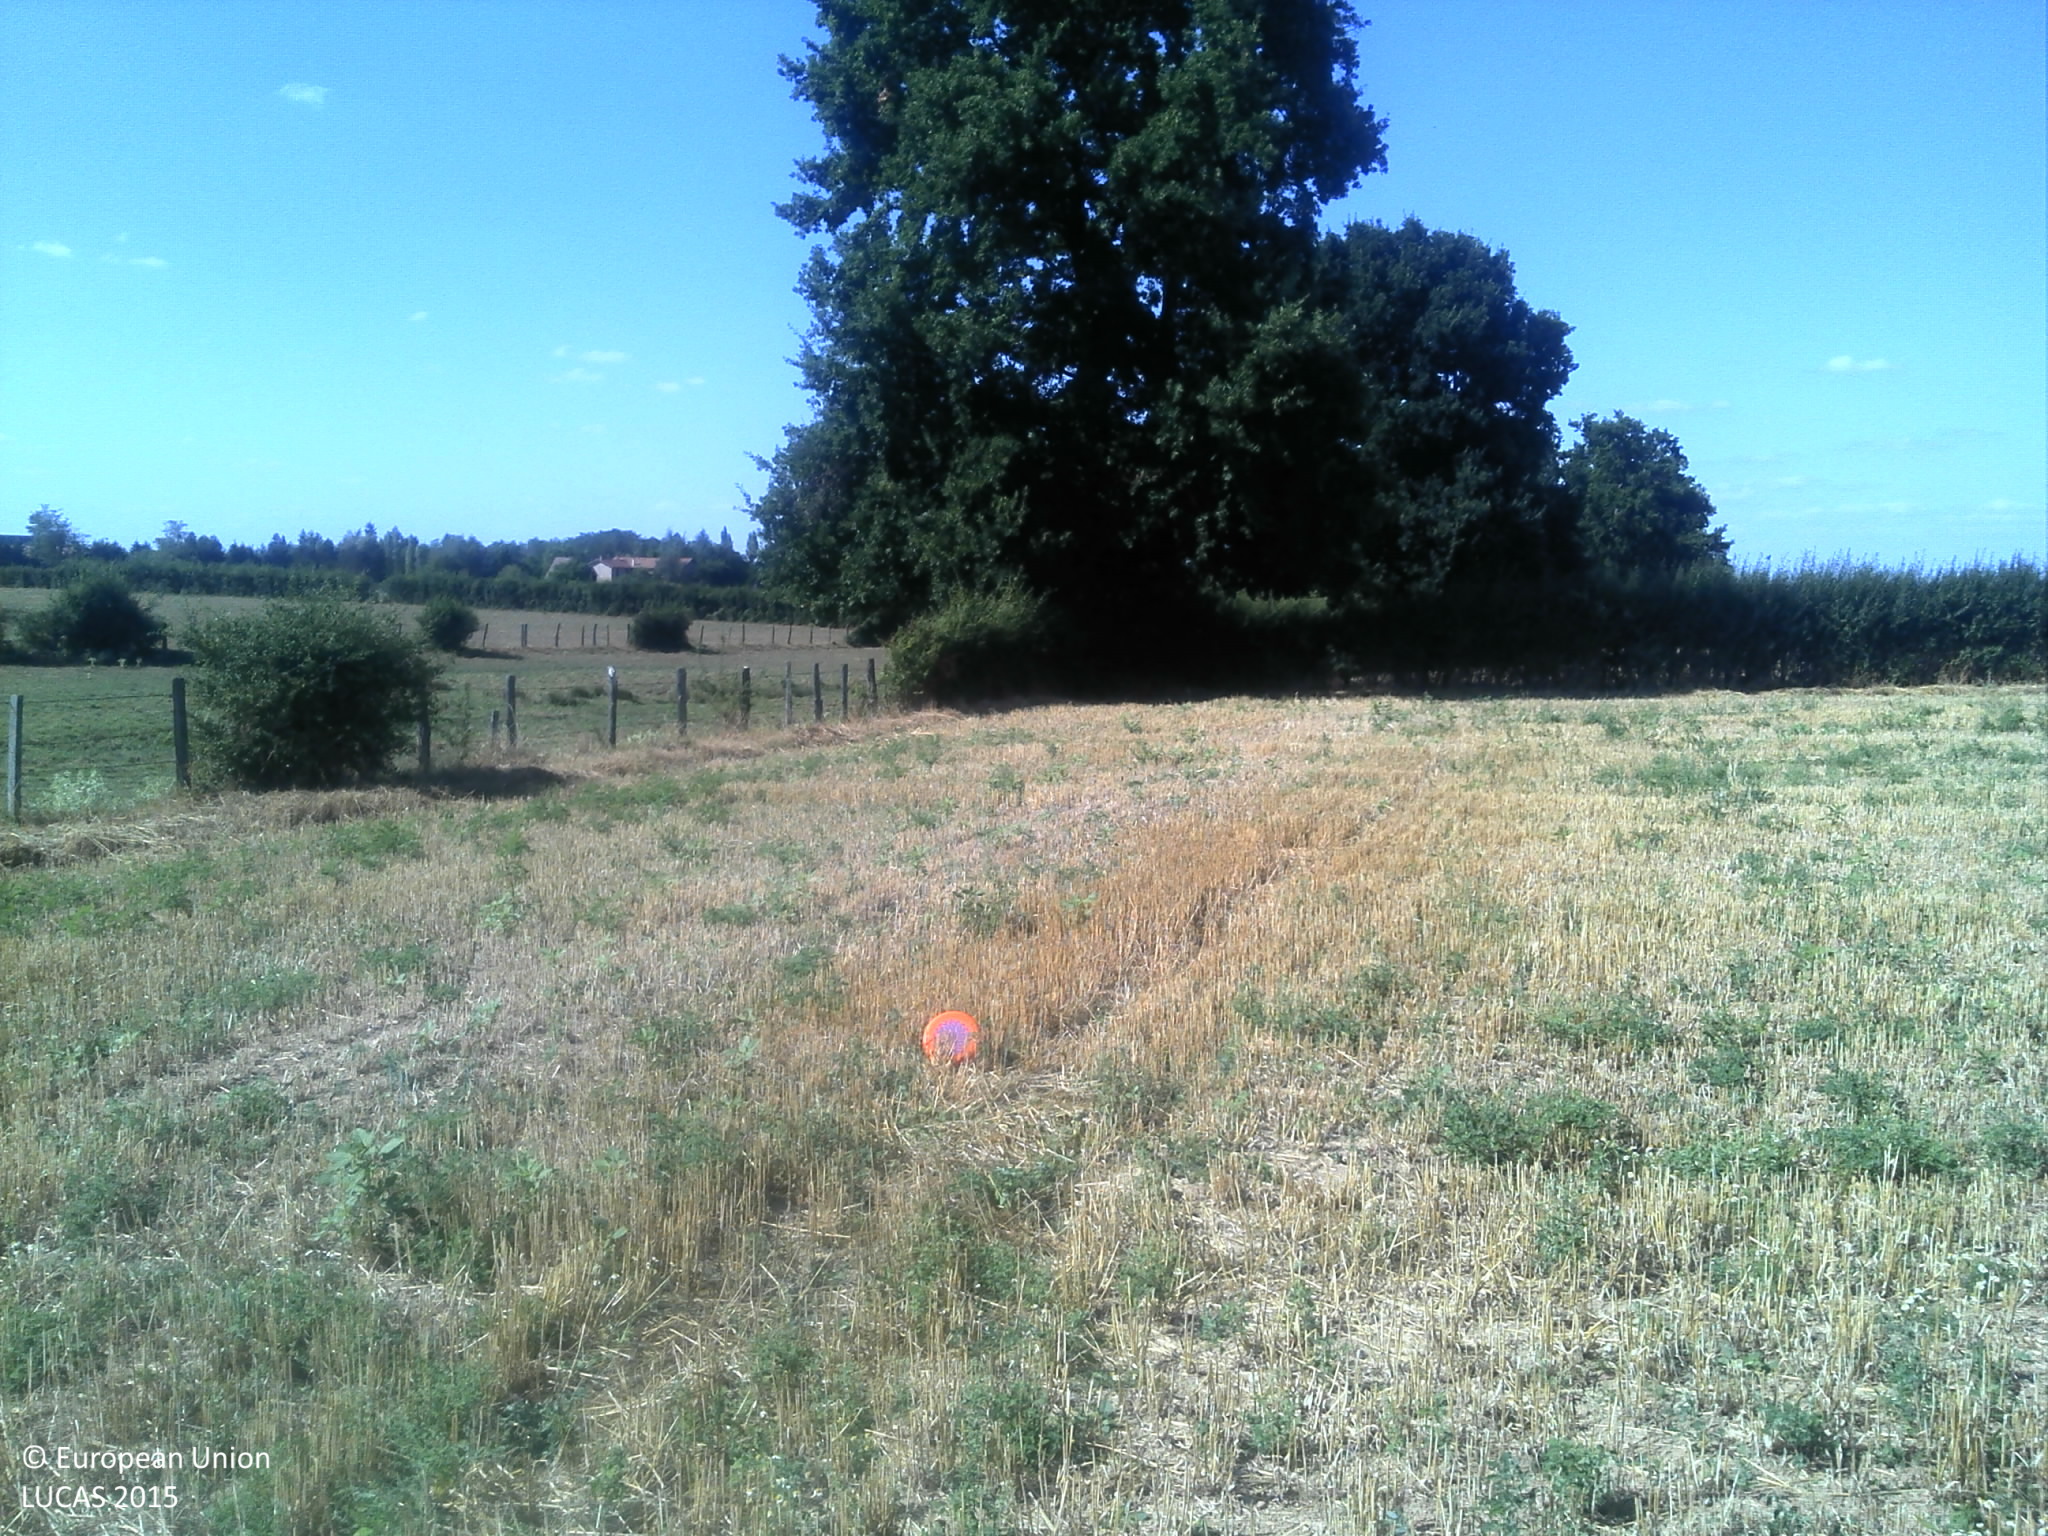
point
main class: Cropland
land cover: Barley
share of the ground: 50 - 75 %
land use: Agriculture (excluding fallow land and kitchen gardens)
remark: Harvested field
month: July
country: FR
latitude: 46.0063
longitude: 4.0742
